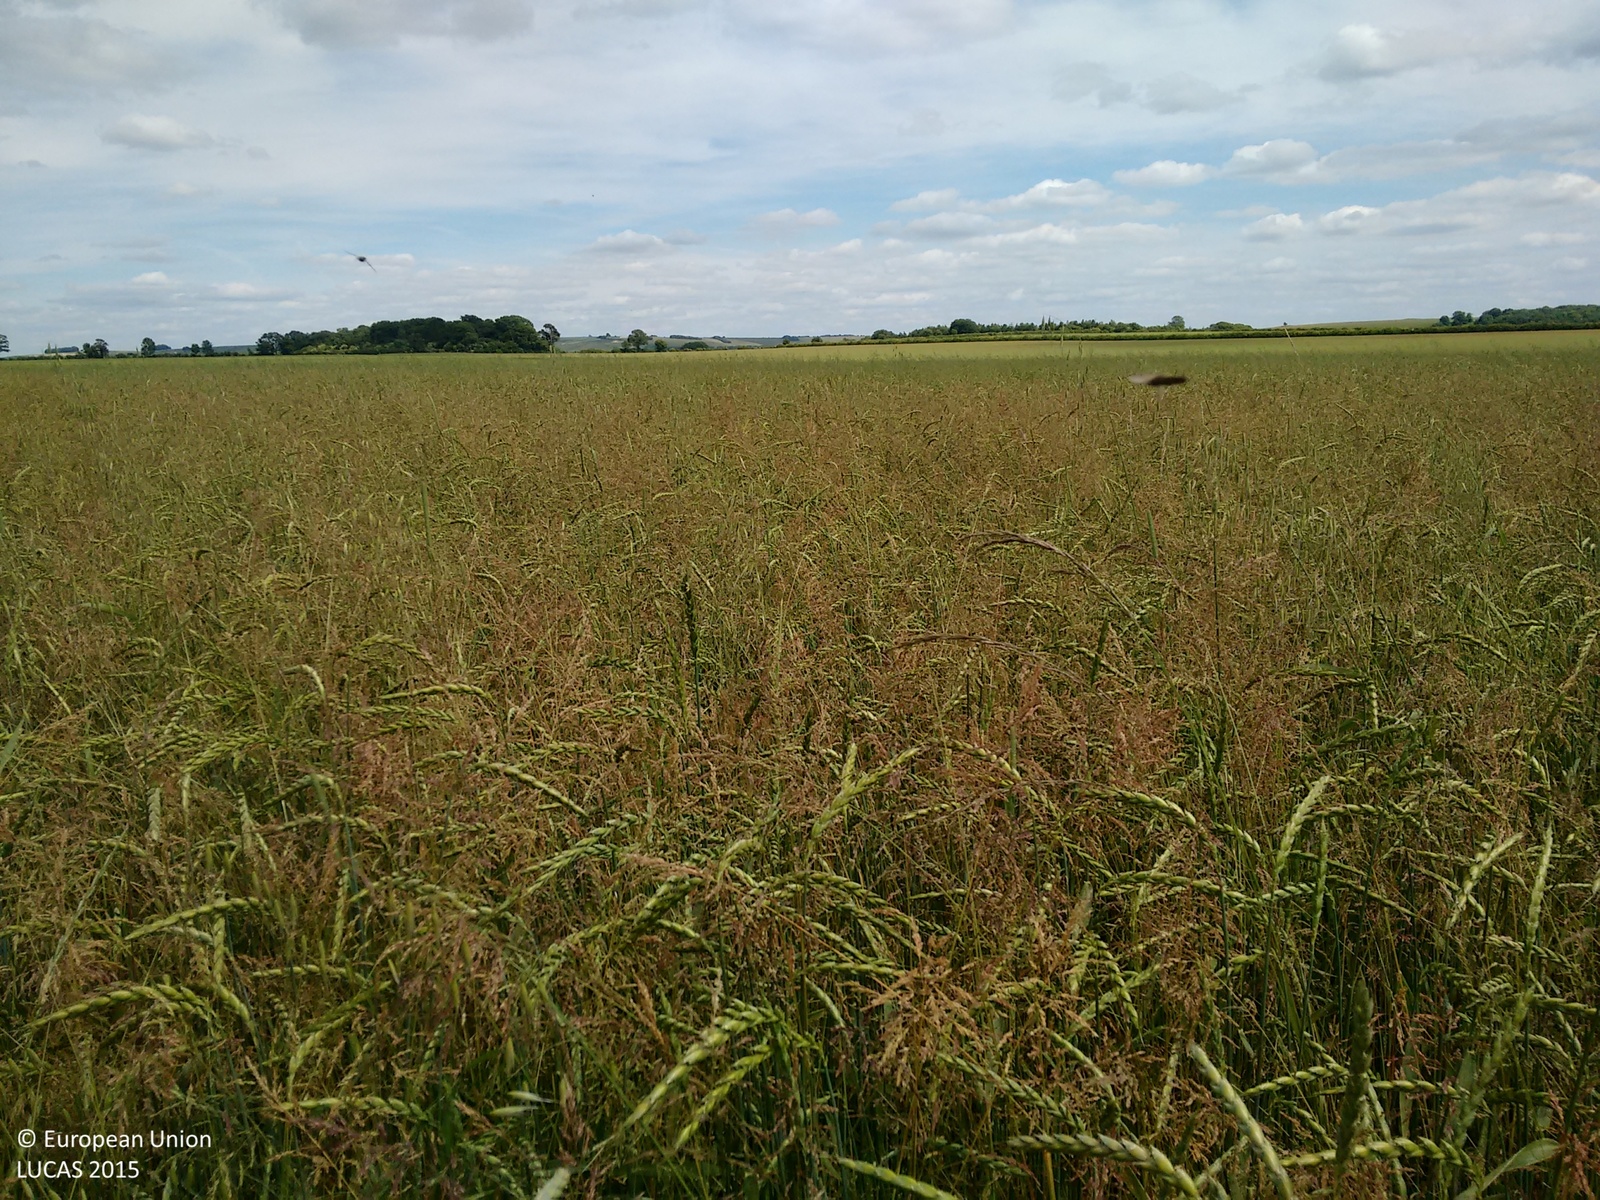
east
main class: Cropland
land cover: Mixed cereals for fodder
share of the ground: > 75 %
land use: Agriculture (excluding fallow land and kitchen gardens)
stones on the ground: < 10 %
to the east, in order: Mixed cereals for fodder; Grass margins; Ditches and canals; Grass margins; Mixed cereals for fodder
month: June
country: GB
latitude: 51.4492
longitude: -1.8995
